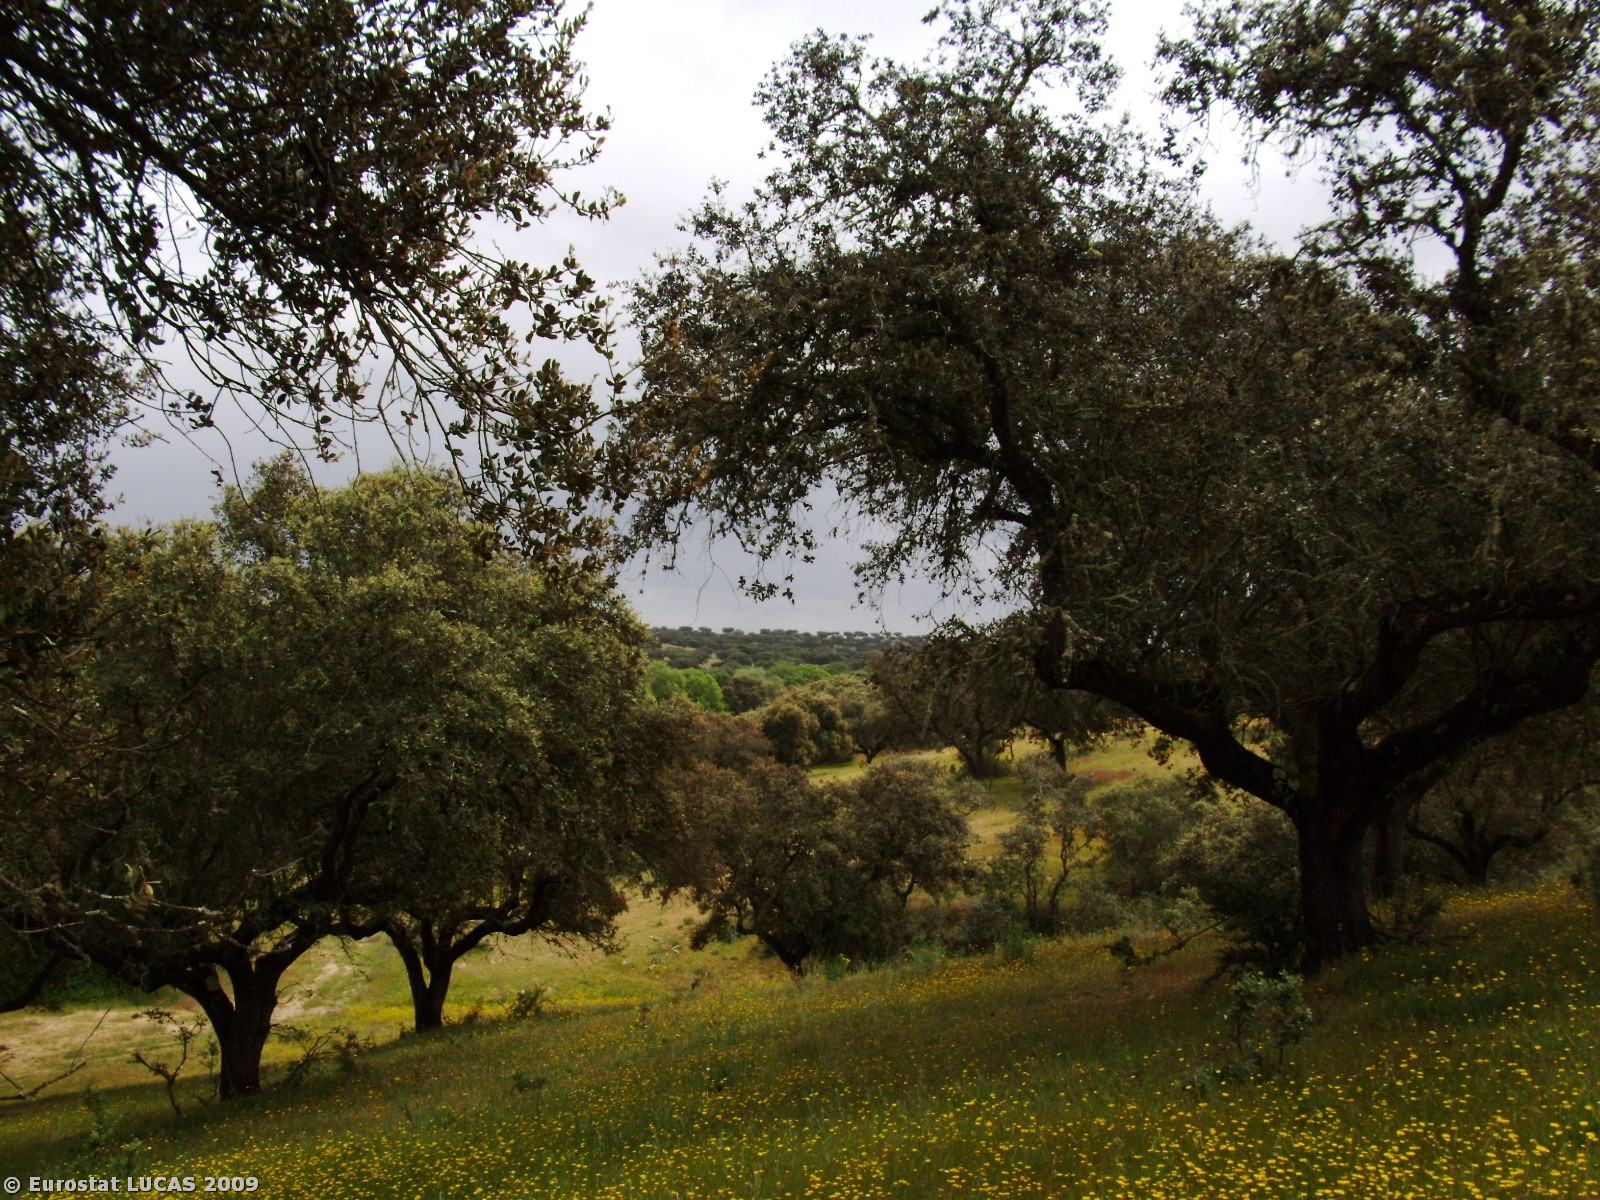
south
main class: Woodland
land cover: Broadleaved woodland
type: broadleaved evergreen forest
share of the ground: 10 - 25 %
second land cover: Spontaneously vegetated surfaces
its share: > 75 %
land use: Forestry
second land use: Fallow land
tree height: > 5 m
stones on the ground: 25 - 50 %
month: April
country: PT
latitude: 38.4953
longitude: -7.7017
